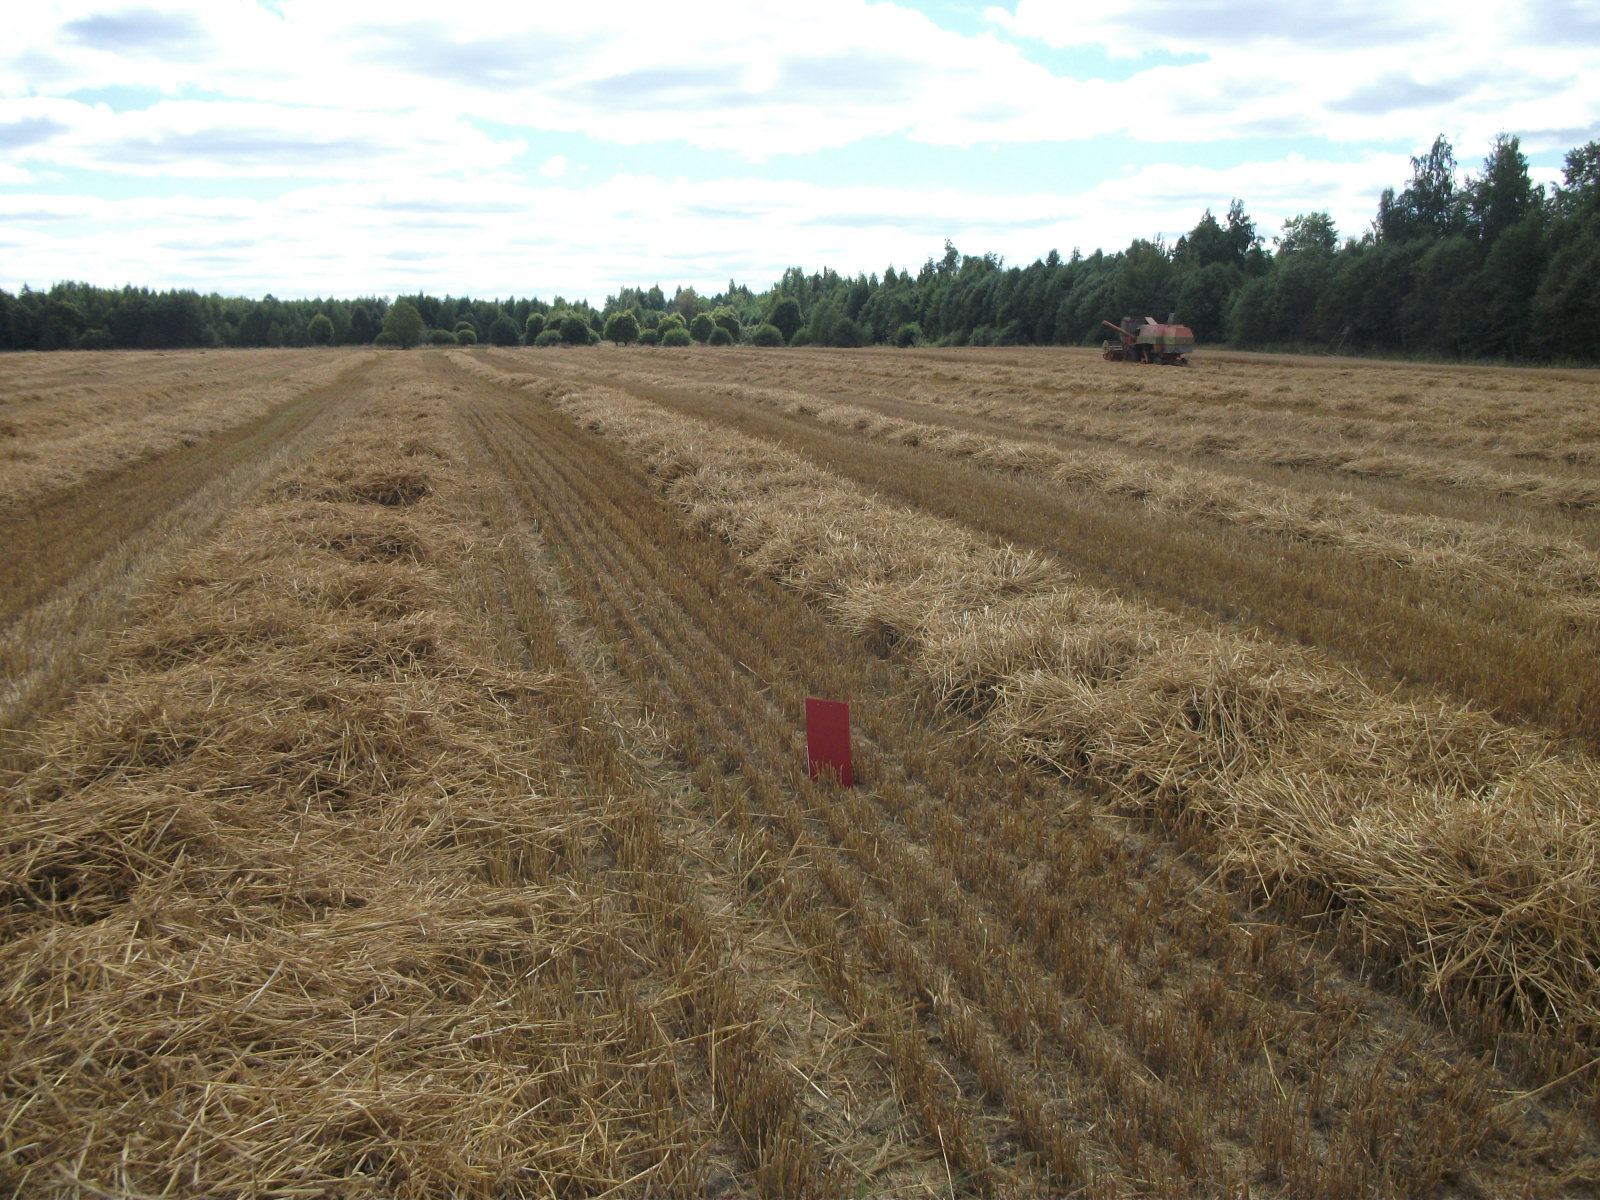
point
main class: Cropland
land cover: Barley
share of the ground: < 10 %
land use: Agriculture (excluding fallow land and kitchen gardens)
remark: Harvested field
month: August
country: LV
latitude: 56.5745
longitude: 26.4057
